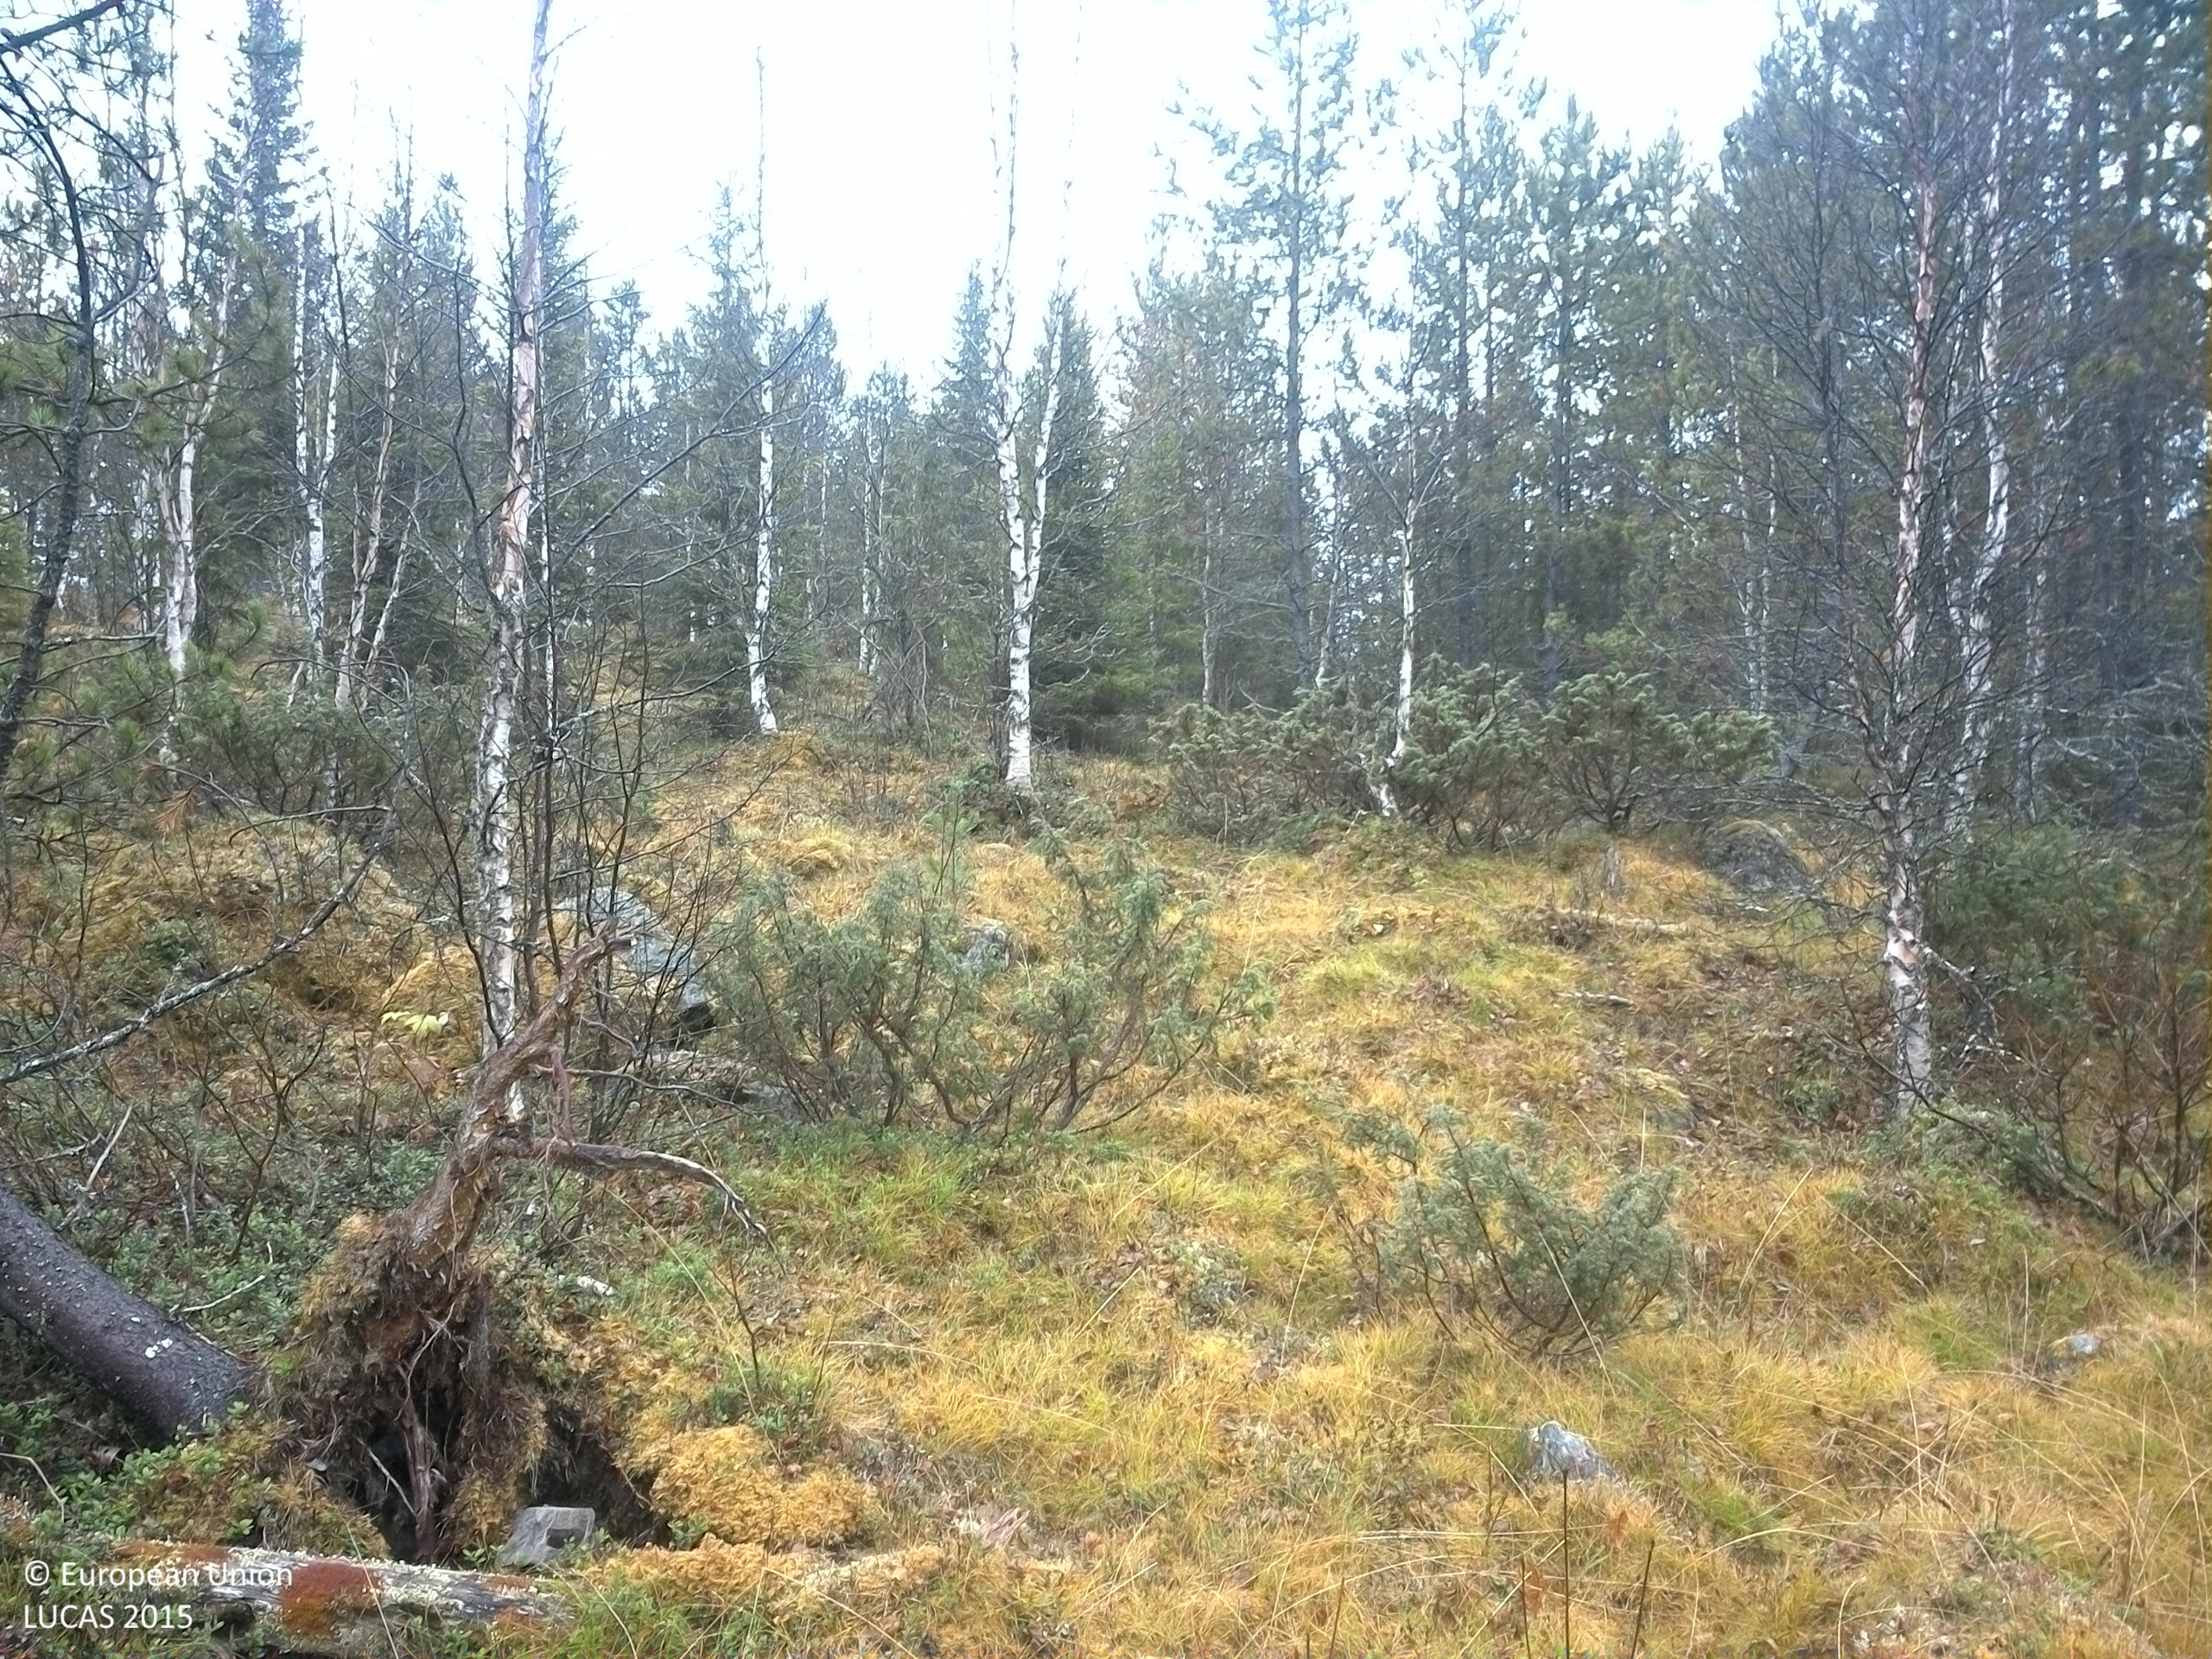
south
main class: Woodland
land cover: Pine dominated mixed woodland
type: exotic forest
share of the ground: 25 - 50 %
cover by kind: coniferous forest trees 30 %, herbaceous plants 25 %, shrubs 20 %, broadleaved forest trees 10 %, lichens and mosses 10 %, consolidated bare surface 5 %
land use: Forestry
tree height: > 5 m
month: October
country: SE
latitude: 64.3211
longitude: 15.4935
